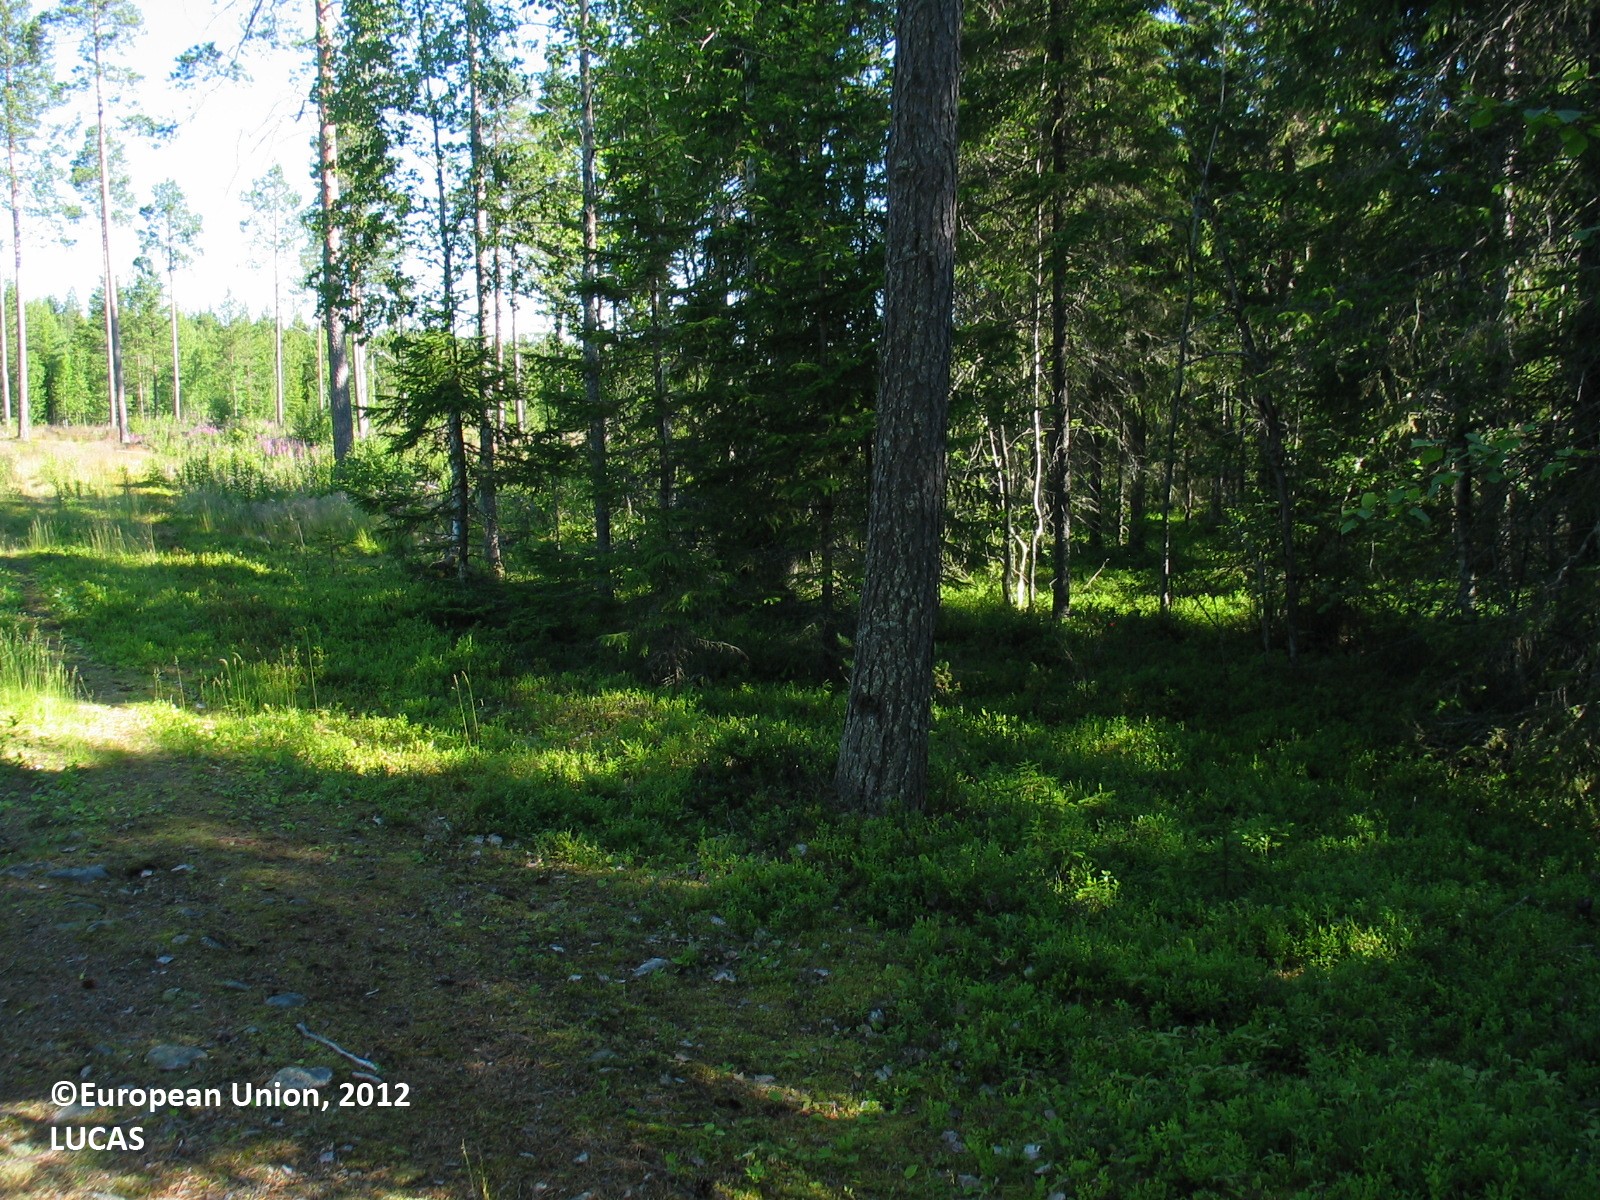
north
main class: Woodland
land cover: Other mixed woodland
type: boreal forest
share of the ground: 50 - 75 %
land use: Forestry
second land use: Sport
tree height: > 5 m
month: July
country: FI
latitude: 65.6598
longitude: 24.9589
